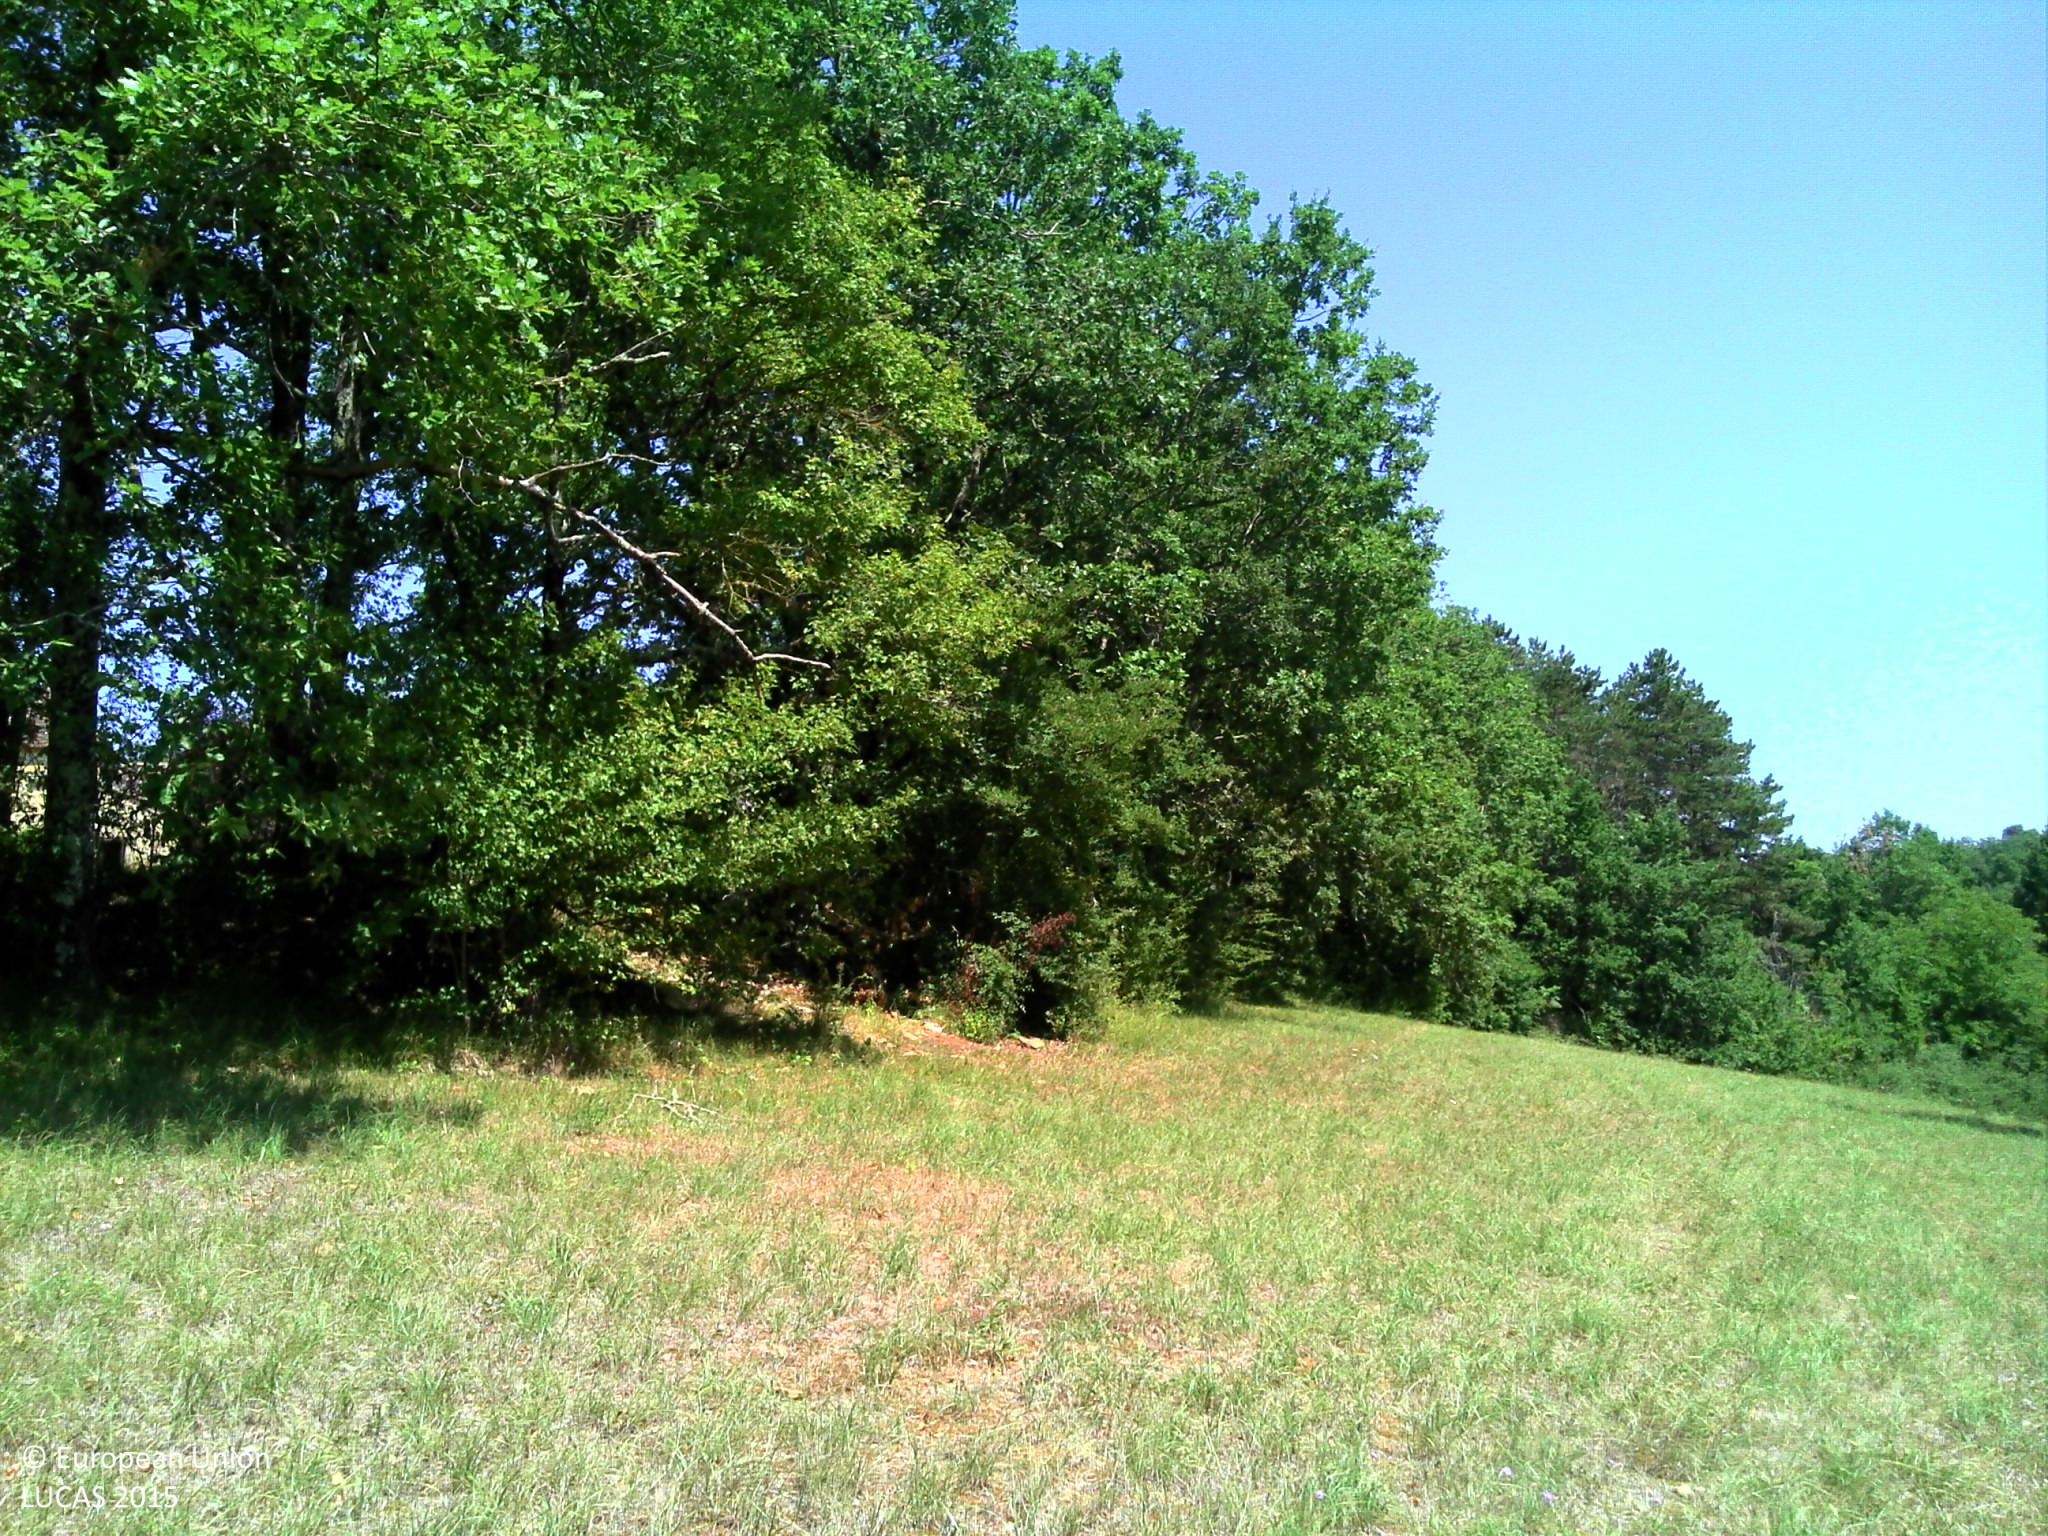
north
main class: Grassland
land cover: Grassland without tree/shrub cover
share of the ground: > 75 %
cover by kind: herbaceous plants 100 %
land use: Agriculture (excluding fallow land and kitchen gardens)
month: August
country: FR
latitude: 44.7604
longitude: 0.8339
